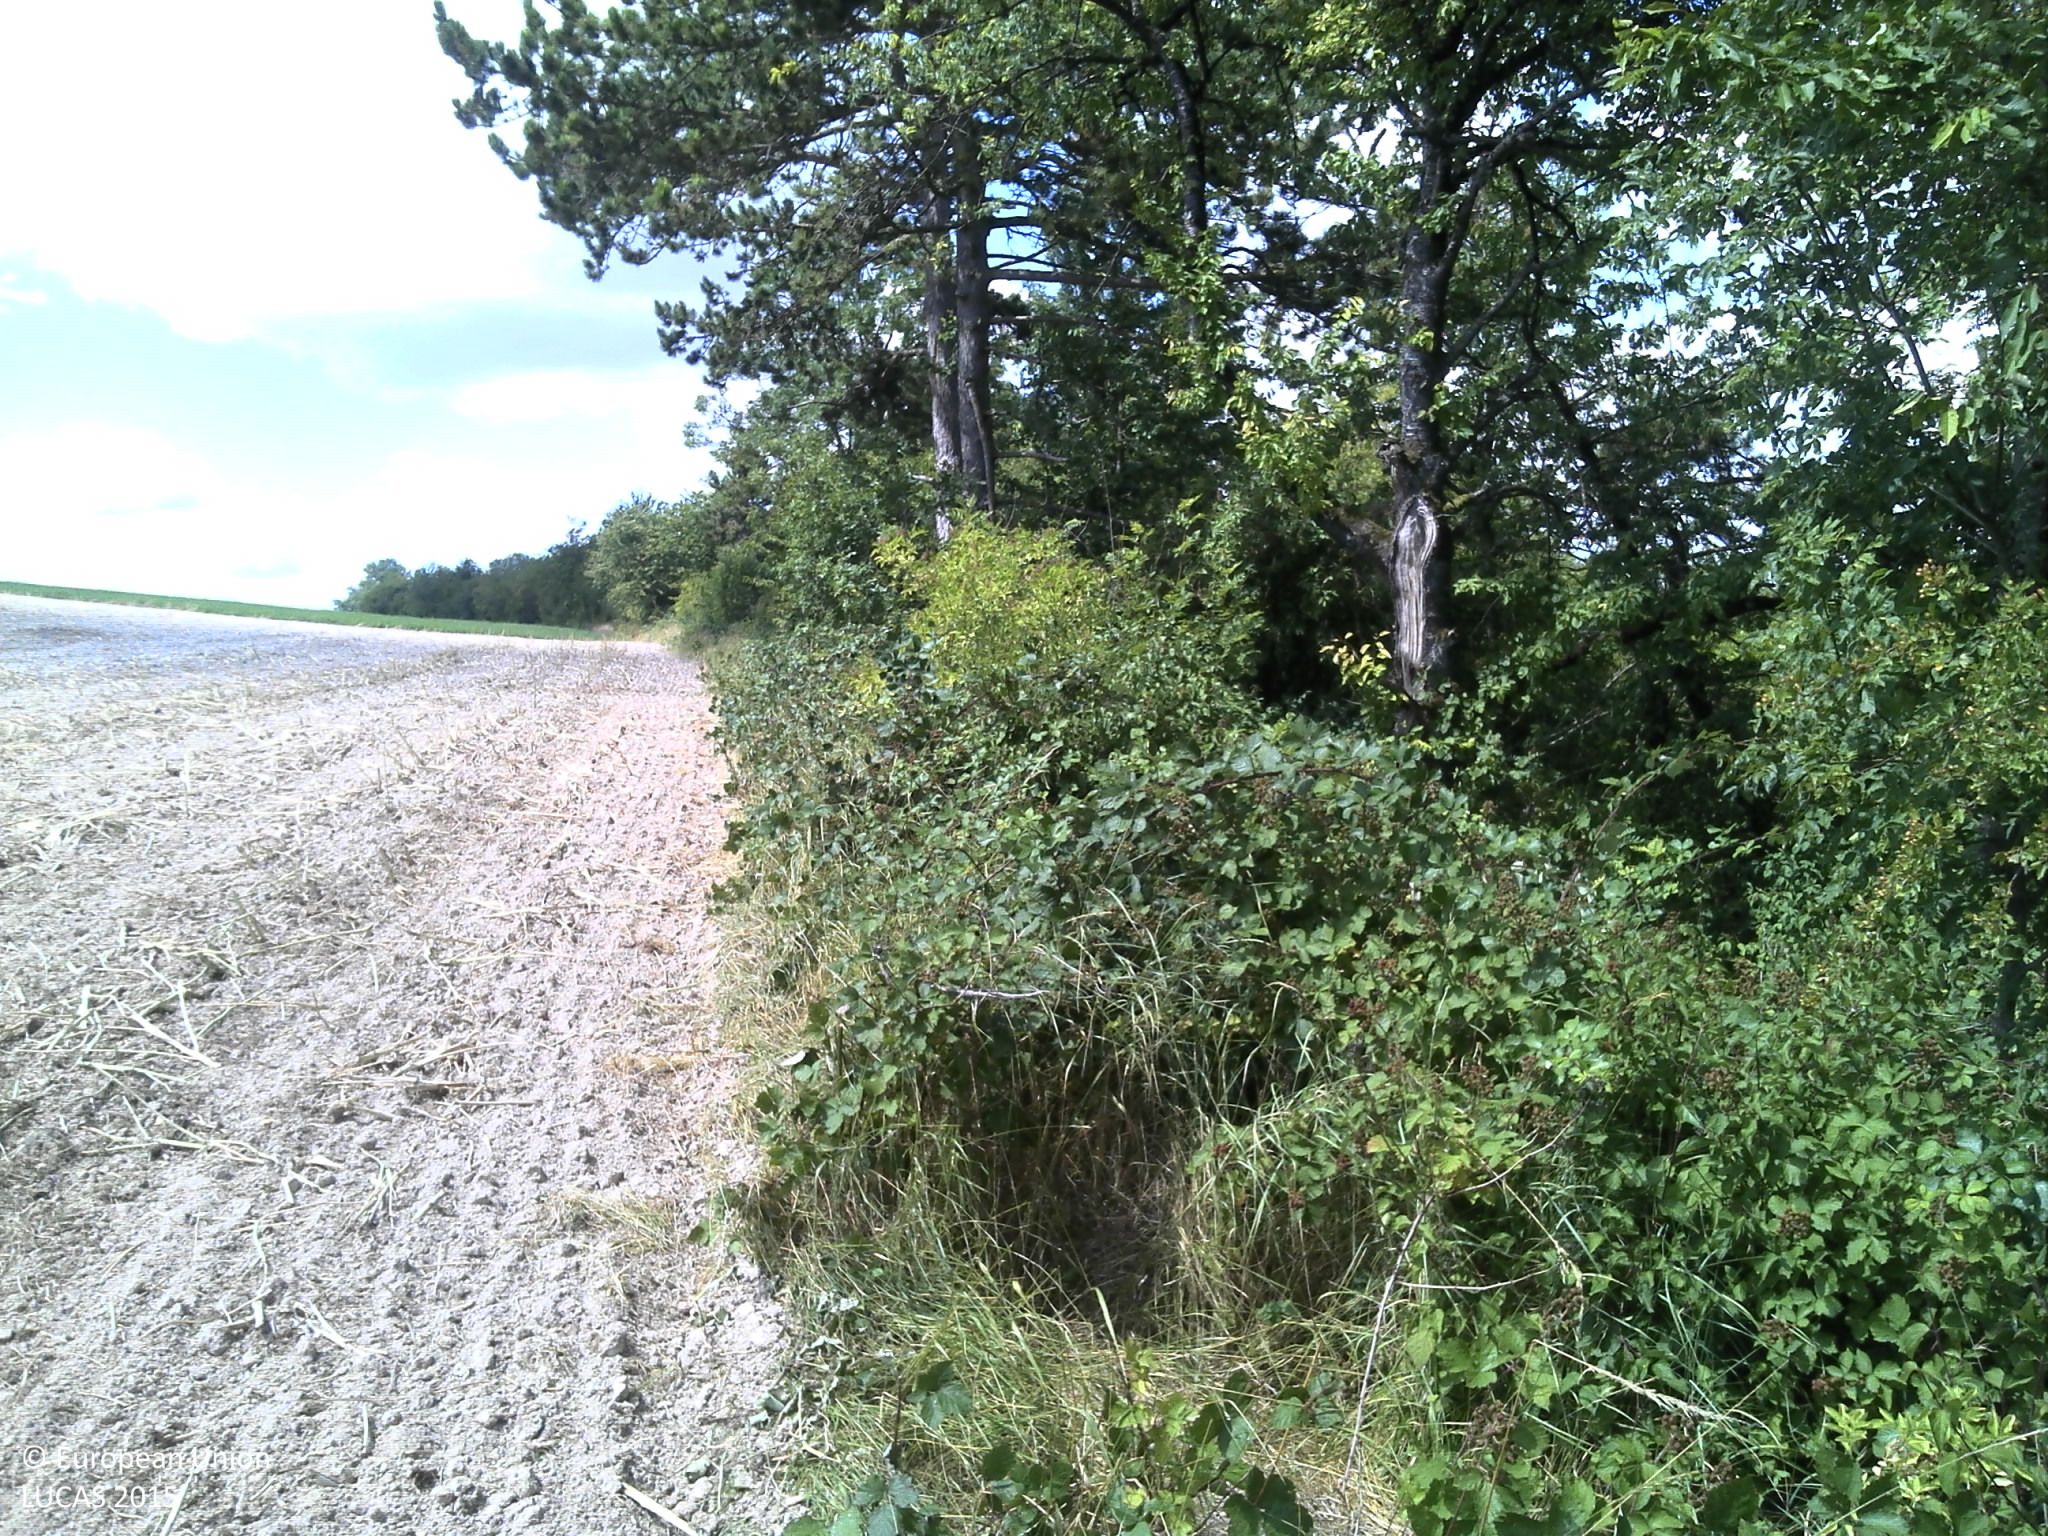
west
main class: Woodland
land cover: Pine dominated mixed woodland
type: alpine coniferous forest
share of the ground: > 75 %
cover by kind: coniferous forest trees 40 %, herbaceous plants 40 %, broadleaved forest trees 20 %
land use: Forestry
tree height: > 5 m
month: July
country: FR
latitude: 49.3195
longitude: 4.6452
